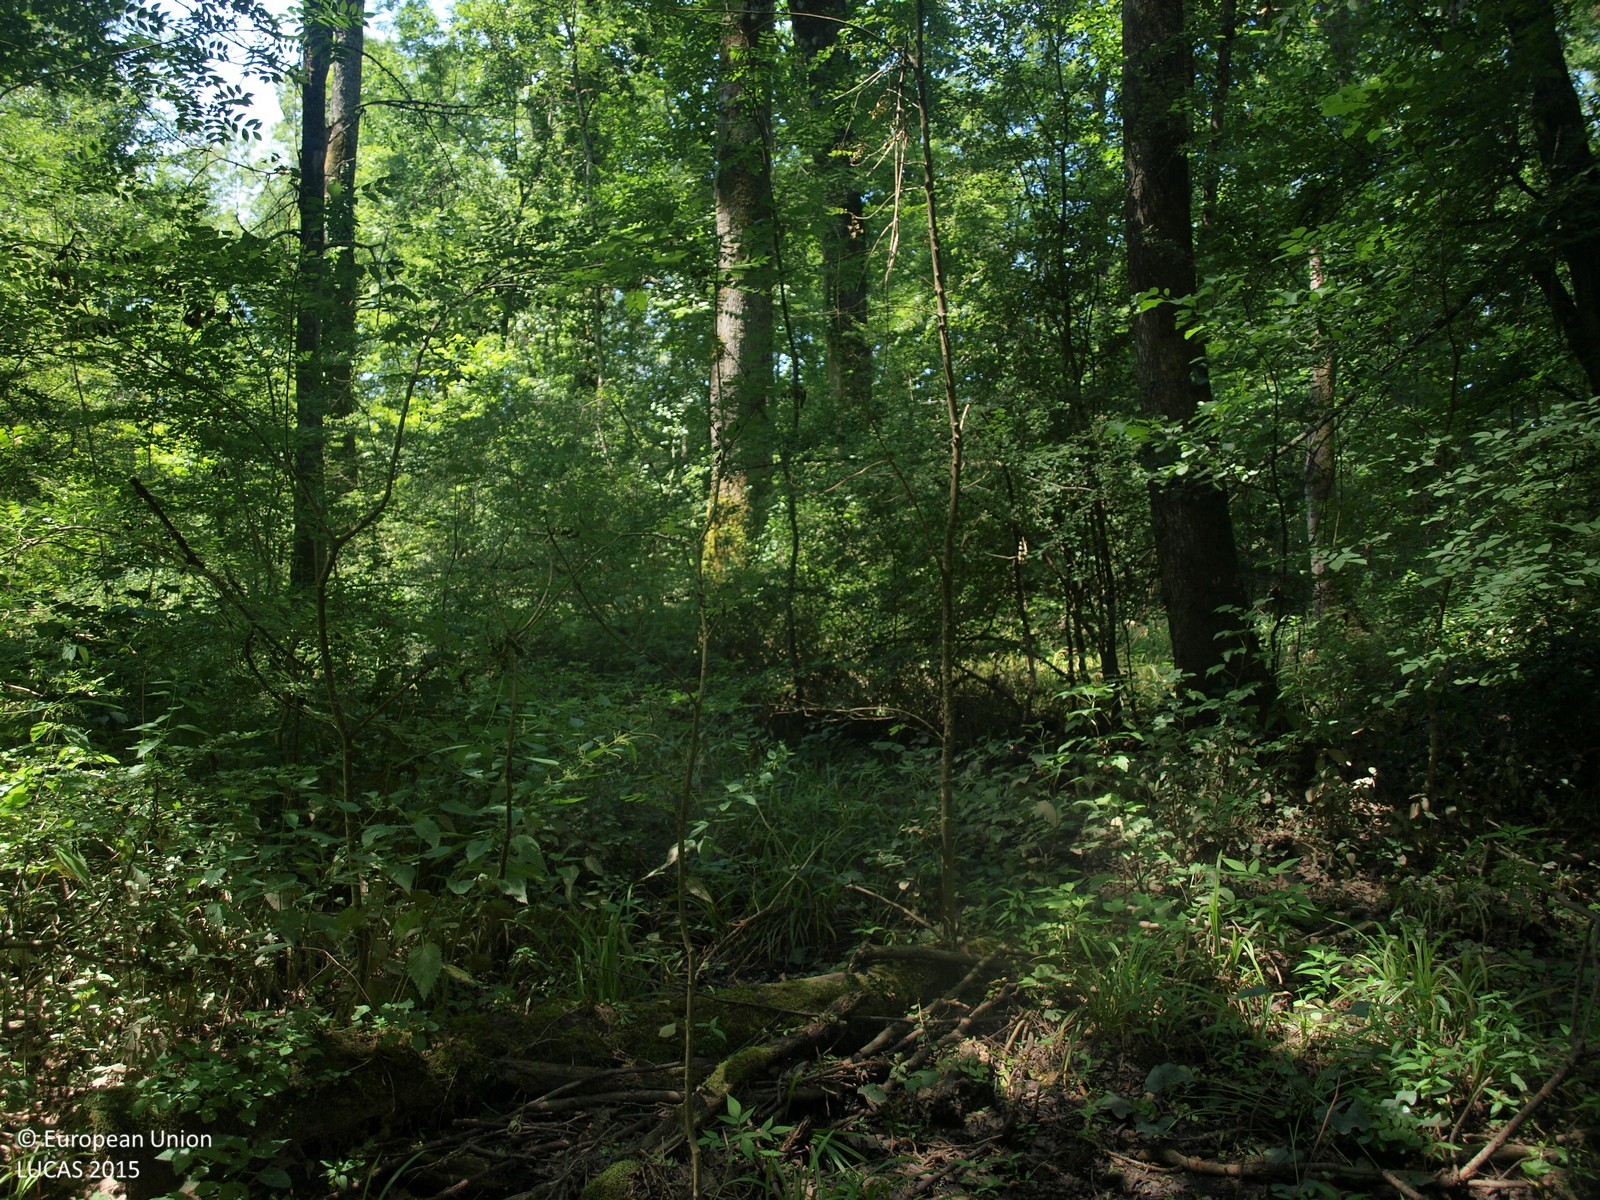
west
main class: Woodland
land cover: Broadleaved woodland
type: floodplain forest
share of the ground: > 75 %
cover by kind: broadleaved forest trees 100 %
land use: Forestry
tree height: > 5 m
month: July
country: HR
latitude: 45.6211
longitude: 15.7041
